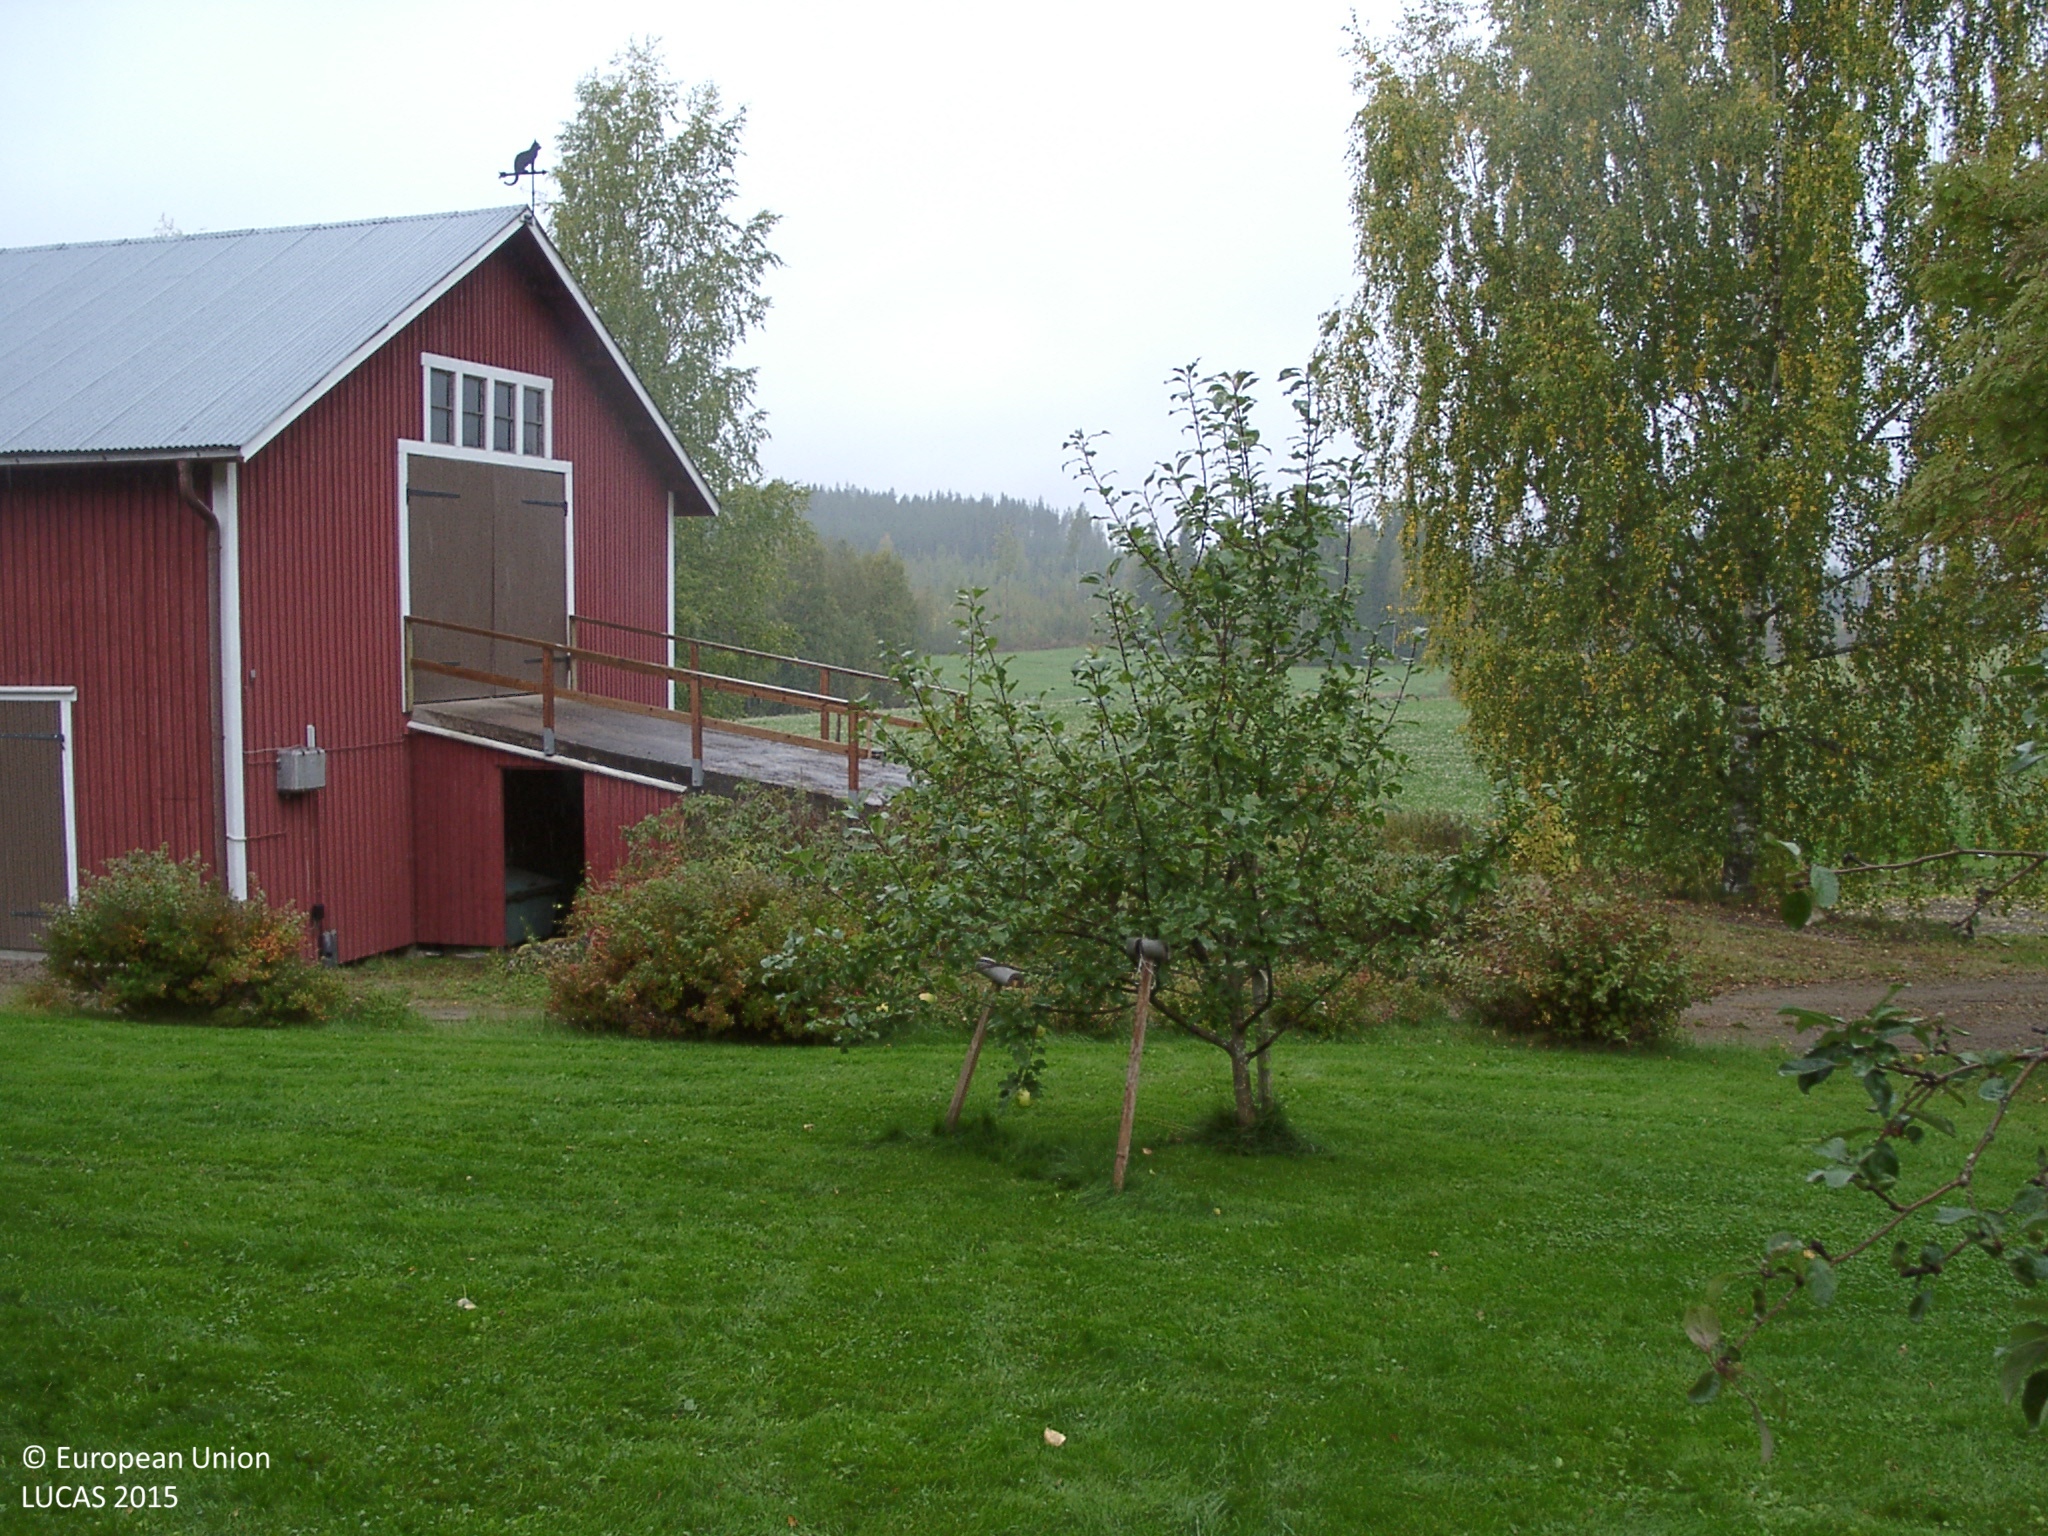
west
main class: Grassland
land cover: Grassland with sparse tree/shrub cover
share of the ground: > 75 %
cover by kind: herbaceous plants 85 %, broadleaved forest trees 5 %, shrubs 5 %, lichens and mosses 5 %
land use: Residential
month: September
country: FI
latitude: 62.5956
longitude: 25.6755
